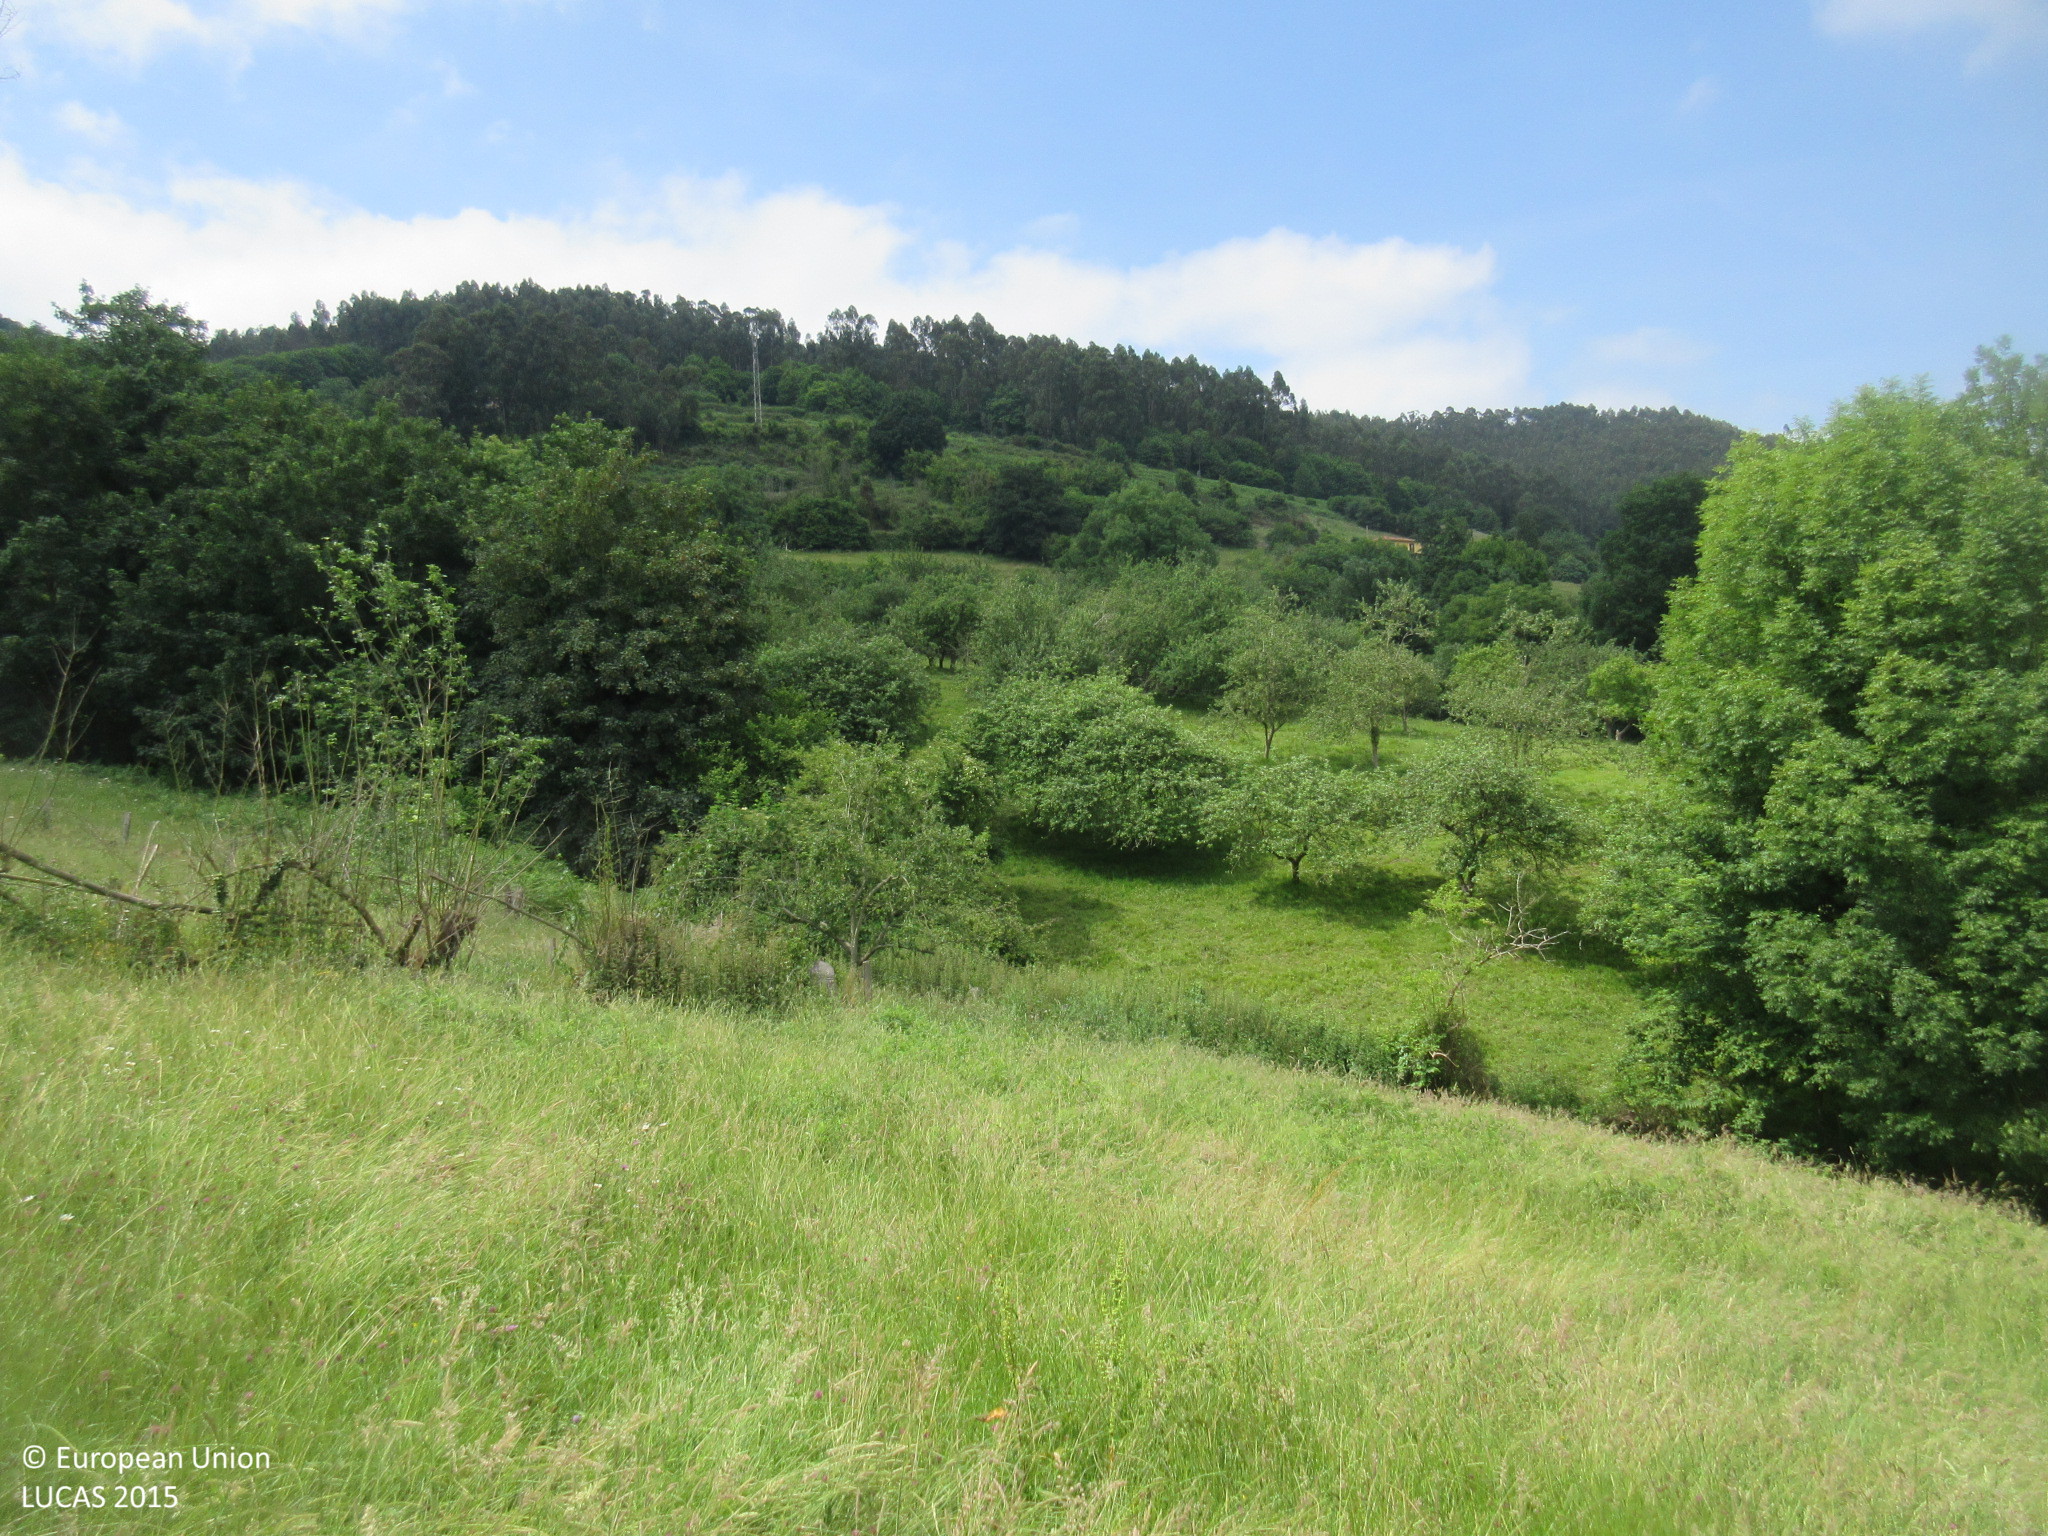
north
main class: Grassland
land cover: Grassland without tree/shrub cover
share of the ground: > 75 %
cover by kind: herbaceous plants 100 %
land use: Agriculture (excluding fallow land and kitchen gardens)
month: June
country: ES
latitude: 43.3396
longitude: -5.9903
